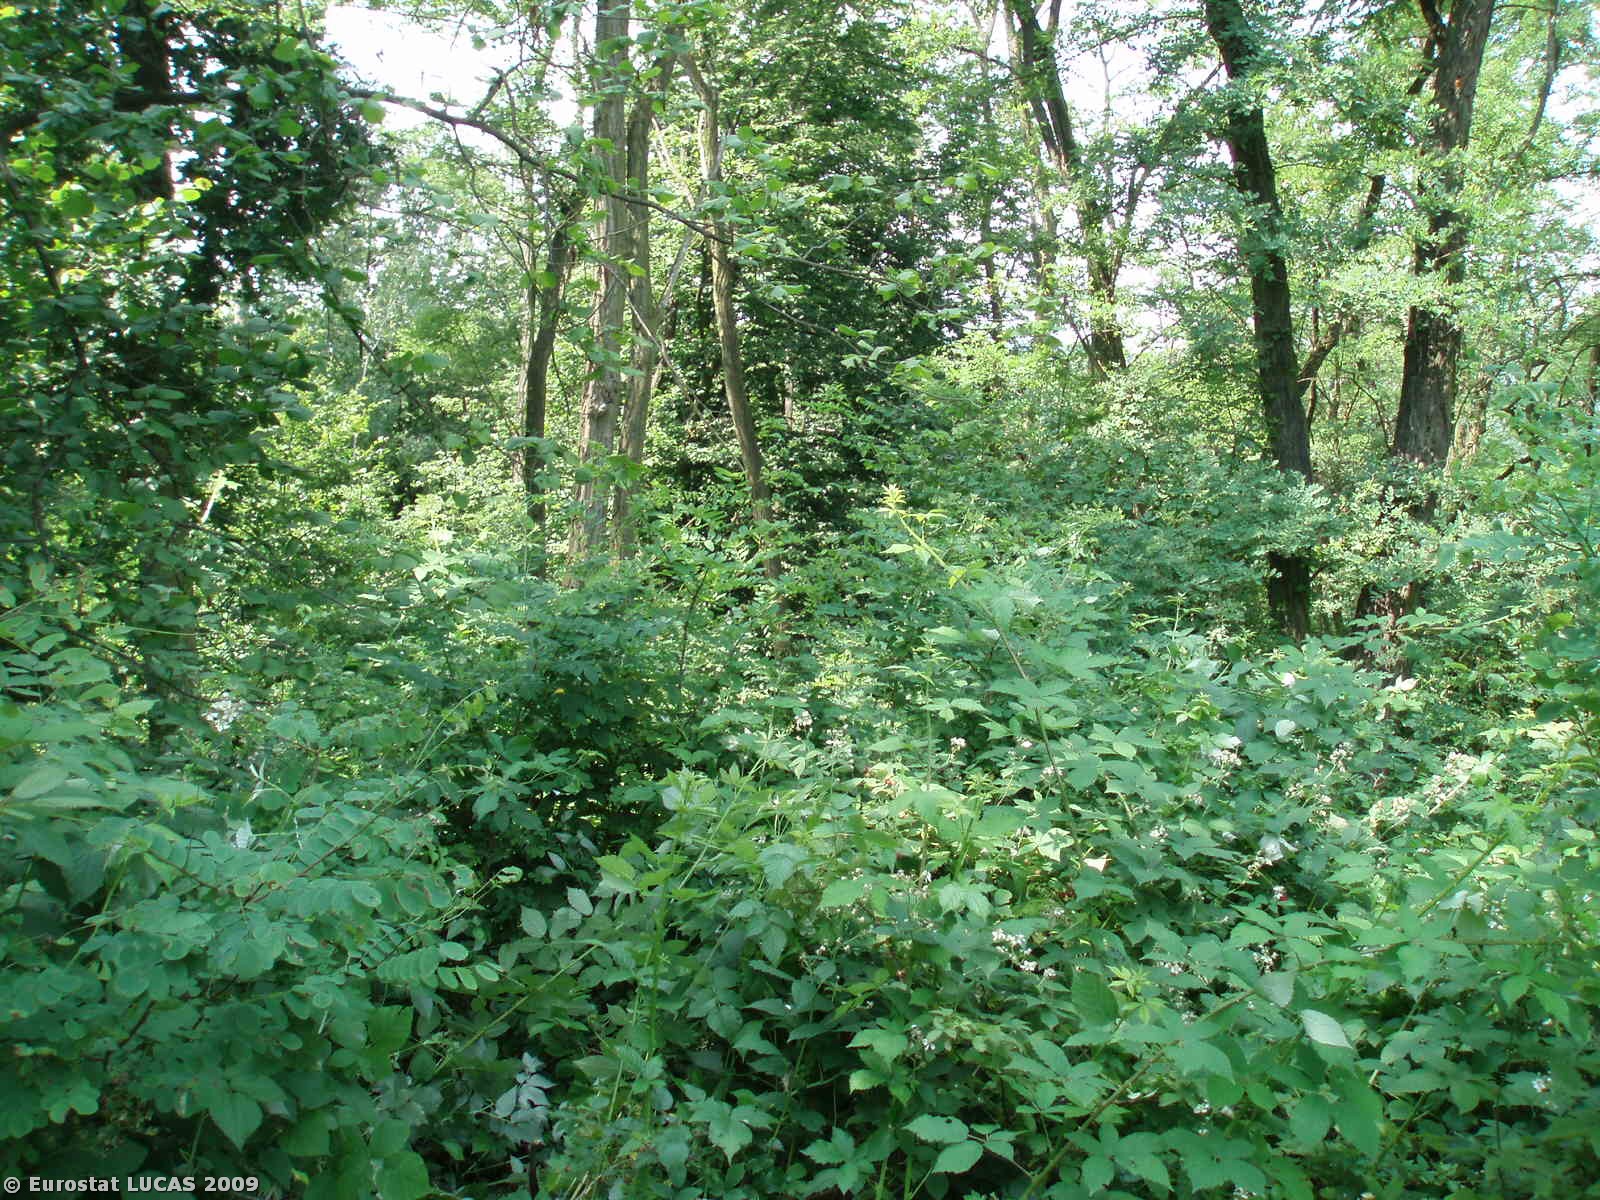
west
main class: Woodland
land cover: Broadleaved woodland
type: plantations and self-sown exotic forest
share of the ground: > 75 %
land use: Forestry
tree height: > 5 m
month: July
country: CZ
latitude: 49.9376
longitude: 14.3904
